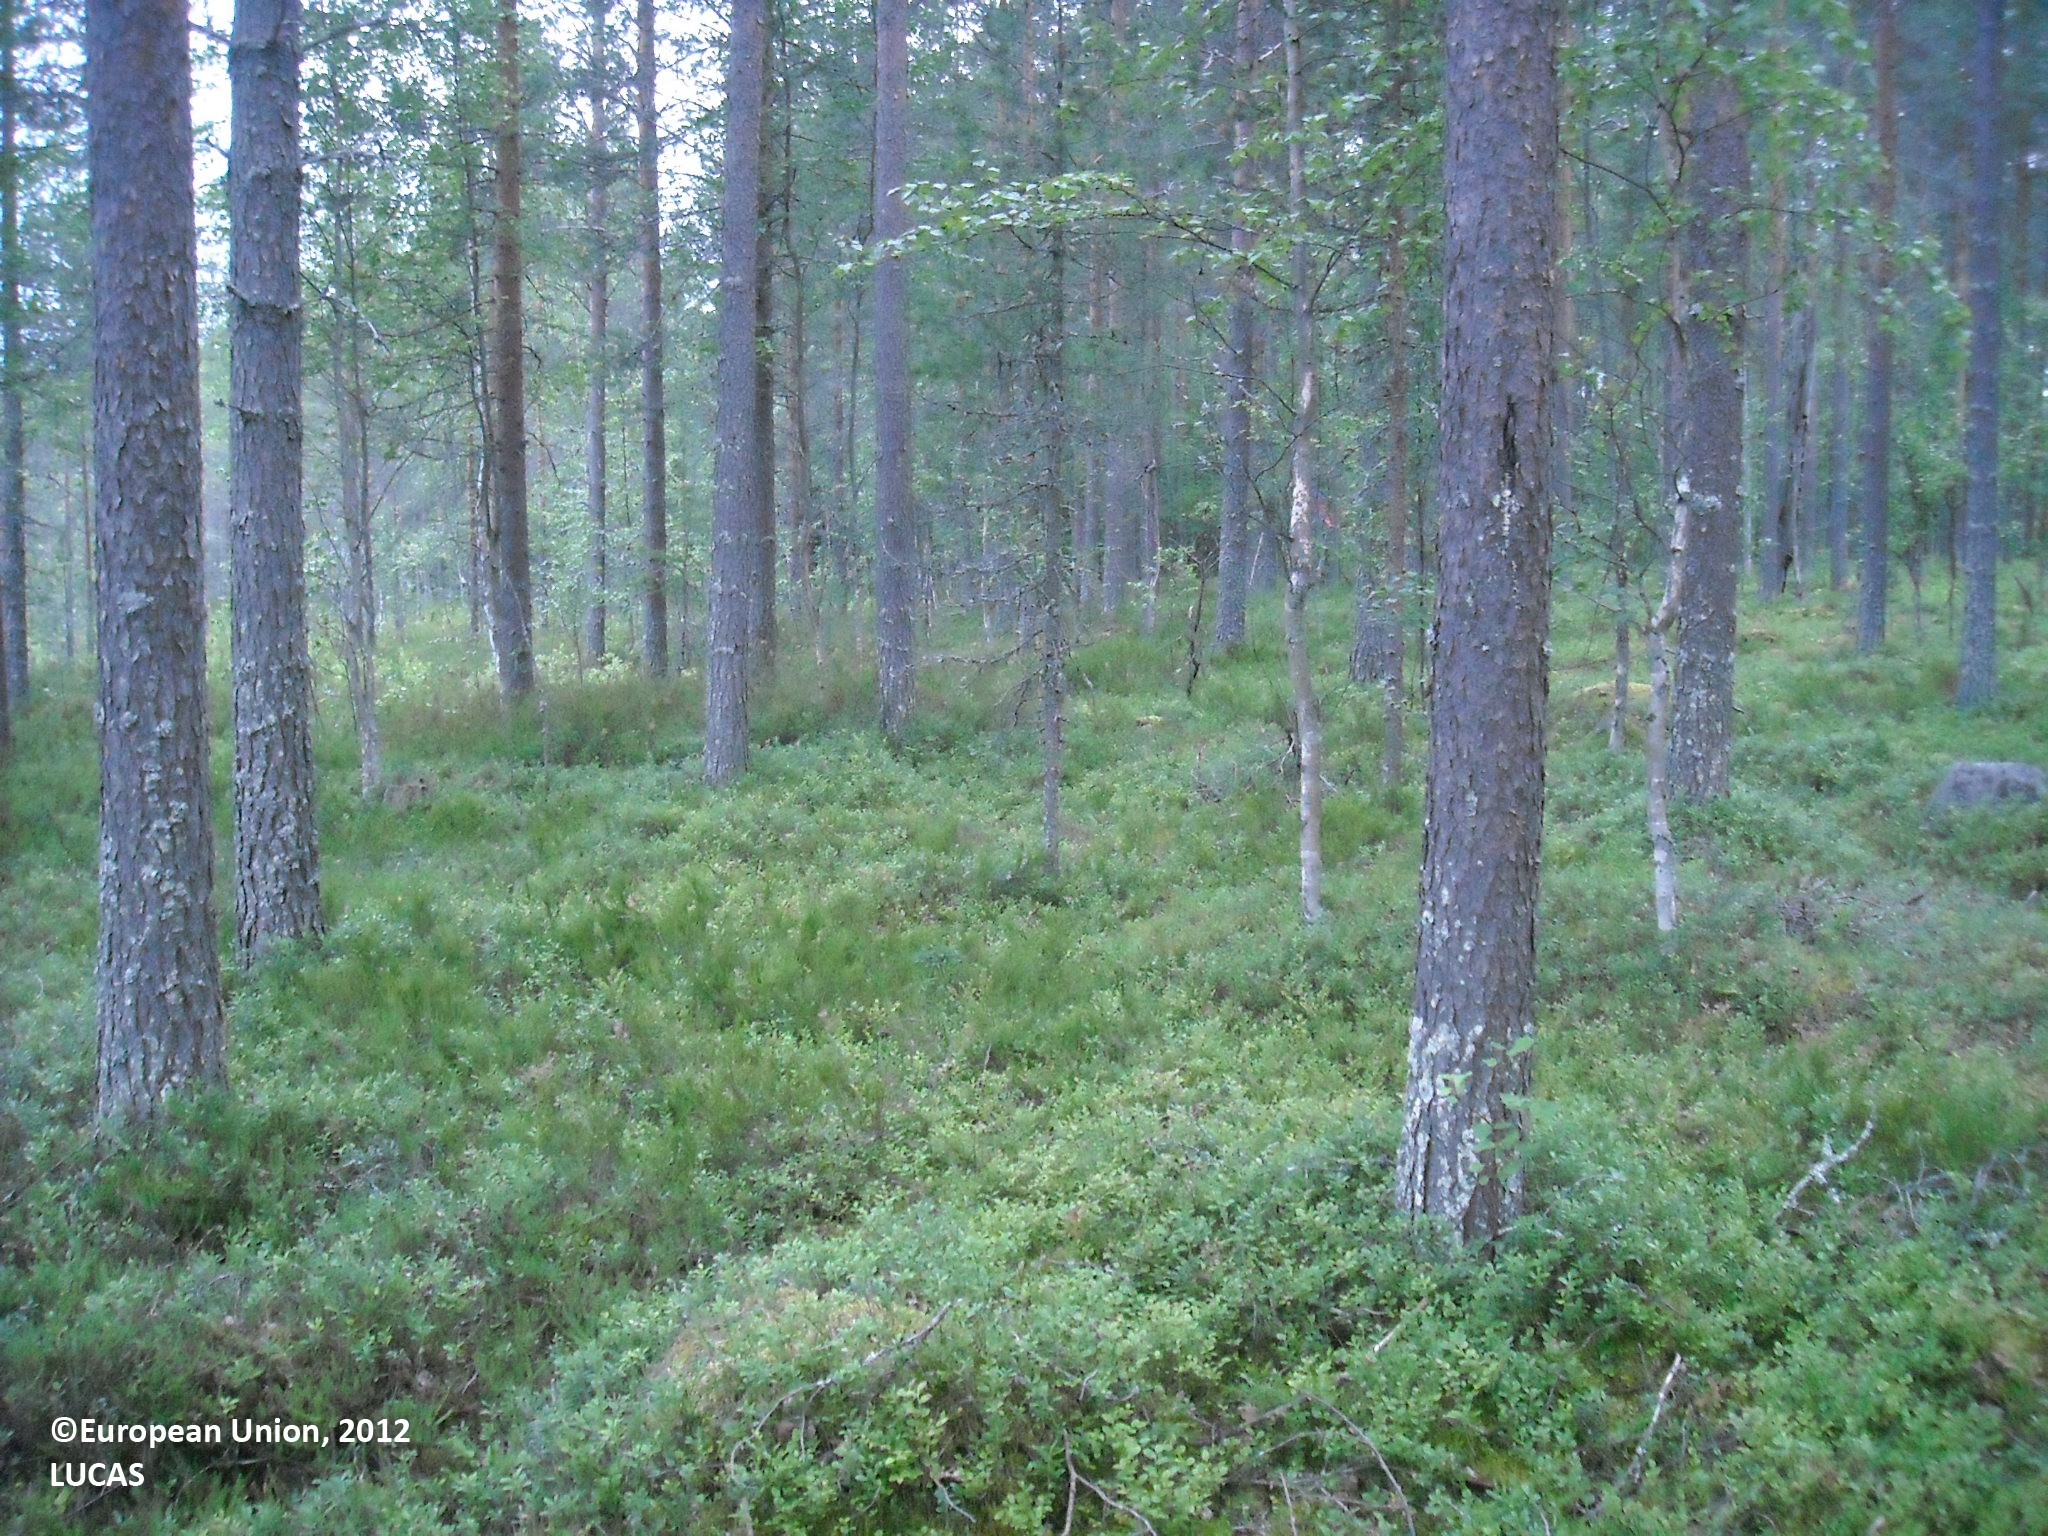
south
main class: Woodland
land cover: Pine dominated coniferous woodland
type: boreal forest
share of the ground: > 75 %
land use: Forestry
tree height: > 5 m
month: July
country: FI
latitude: 65.0440
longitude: 26.7026
